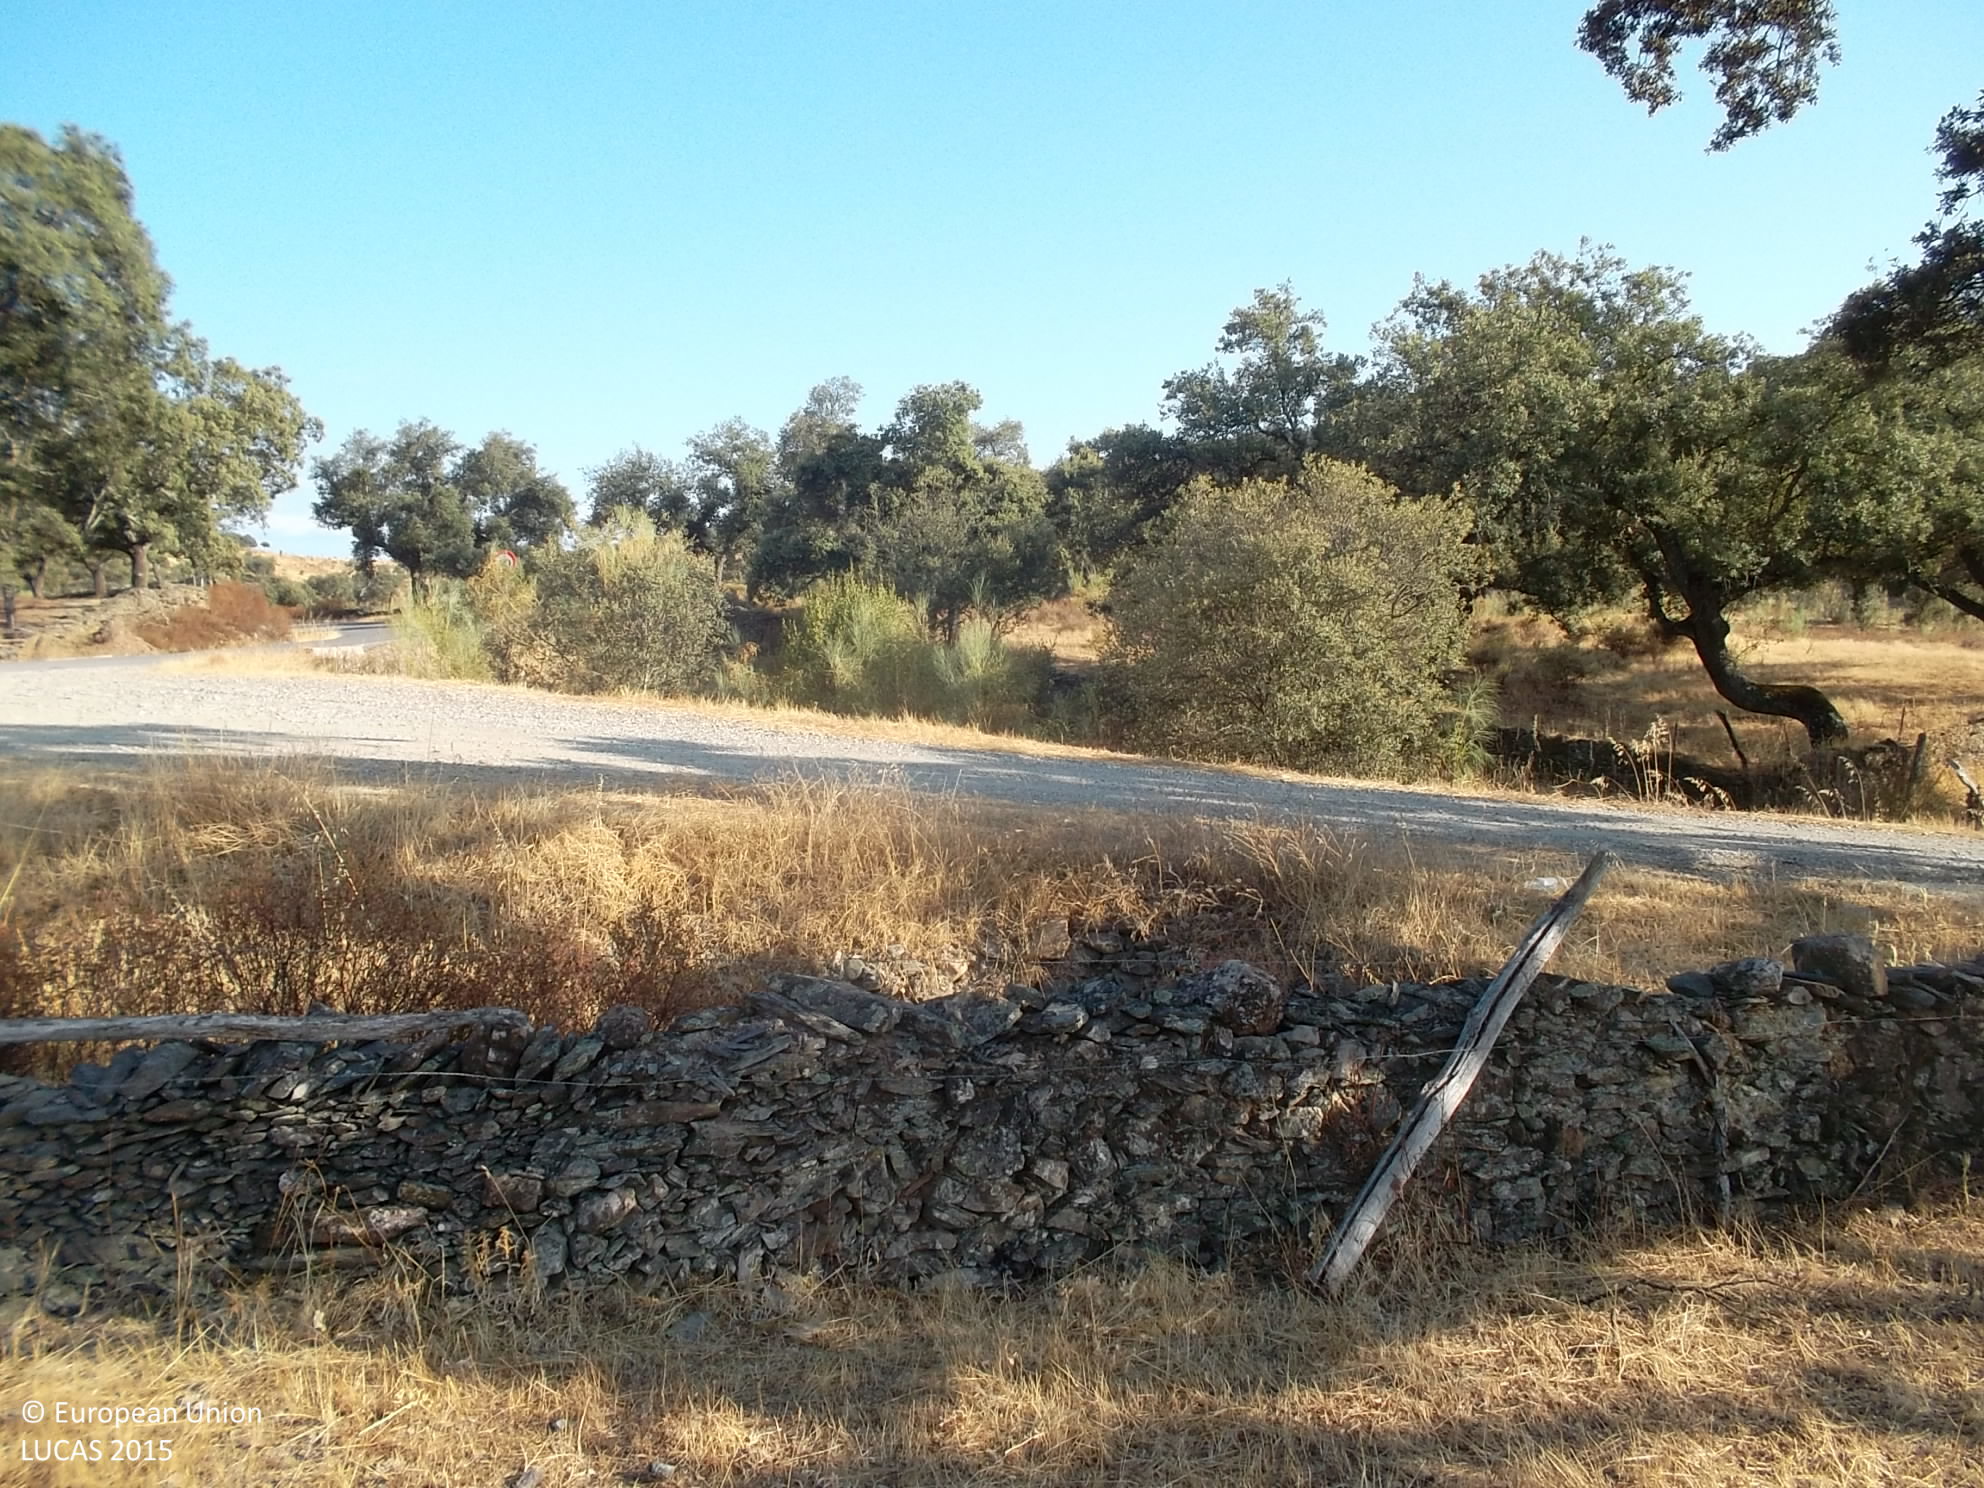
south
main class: Woodland
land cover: Broadleaved woodland
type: broadleaved evergreen forest
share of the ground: 25 - 50 %
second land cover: Grassland without tree/shrub cover
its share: > 75 %
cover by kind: herbaceous plants 75 %, broadleaved forest trees 25 %
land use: Forestry
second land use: Agriculture (excluding fallow land and kitchen gardens)
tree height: > 5 m
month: September
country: ES
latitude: 38.0149
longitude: -6.4802
